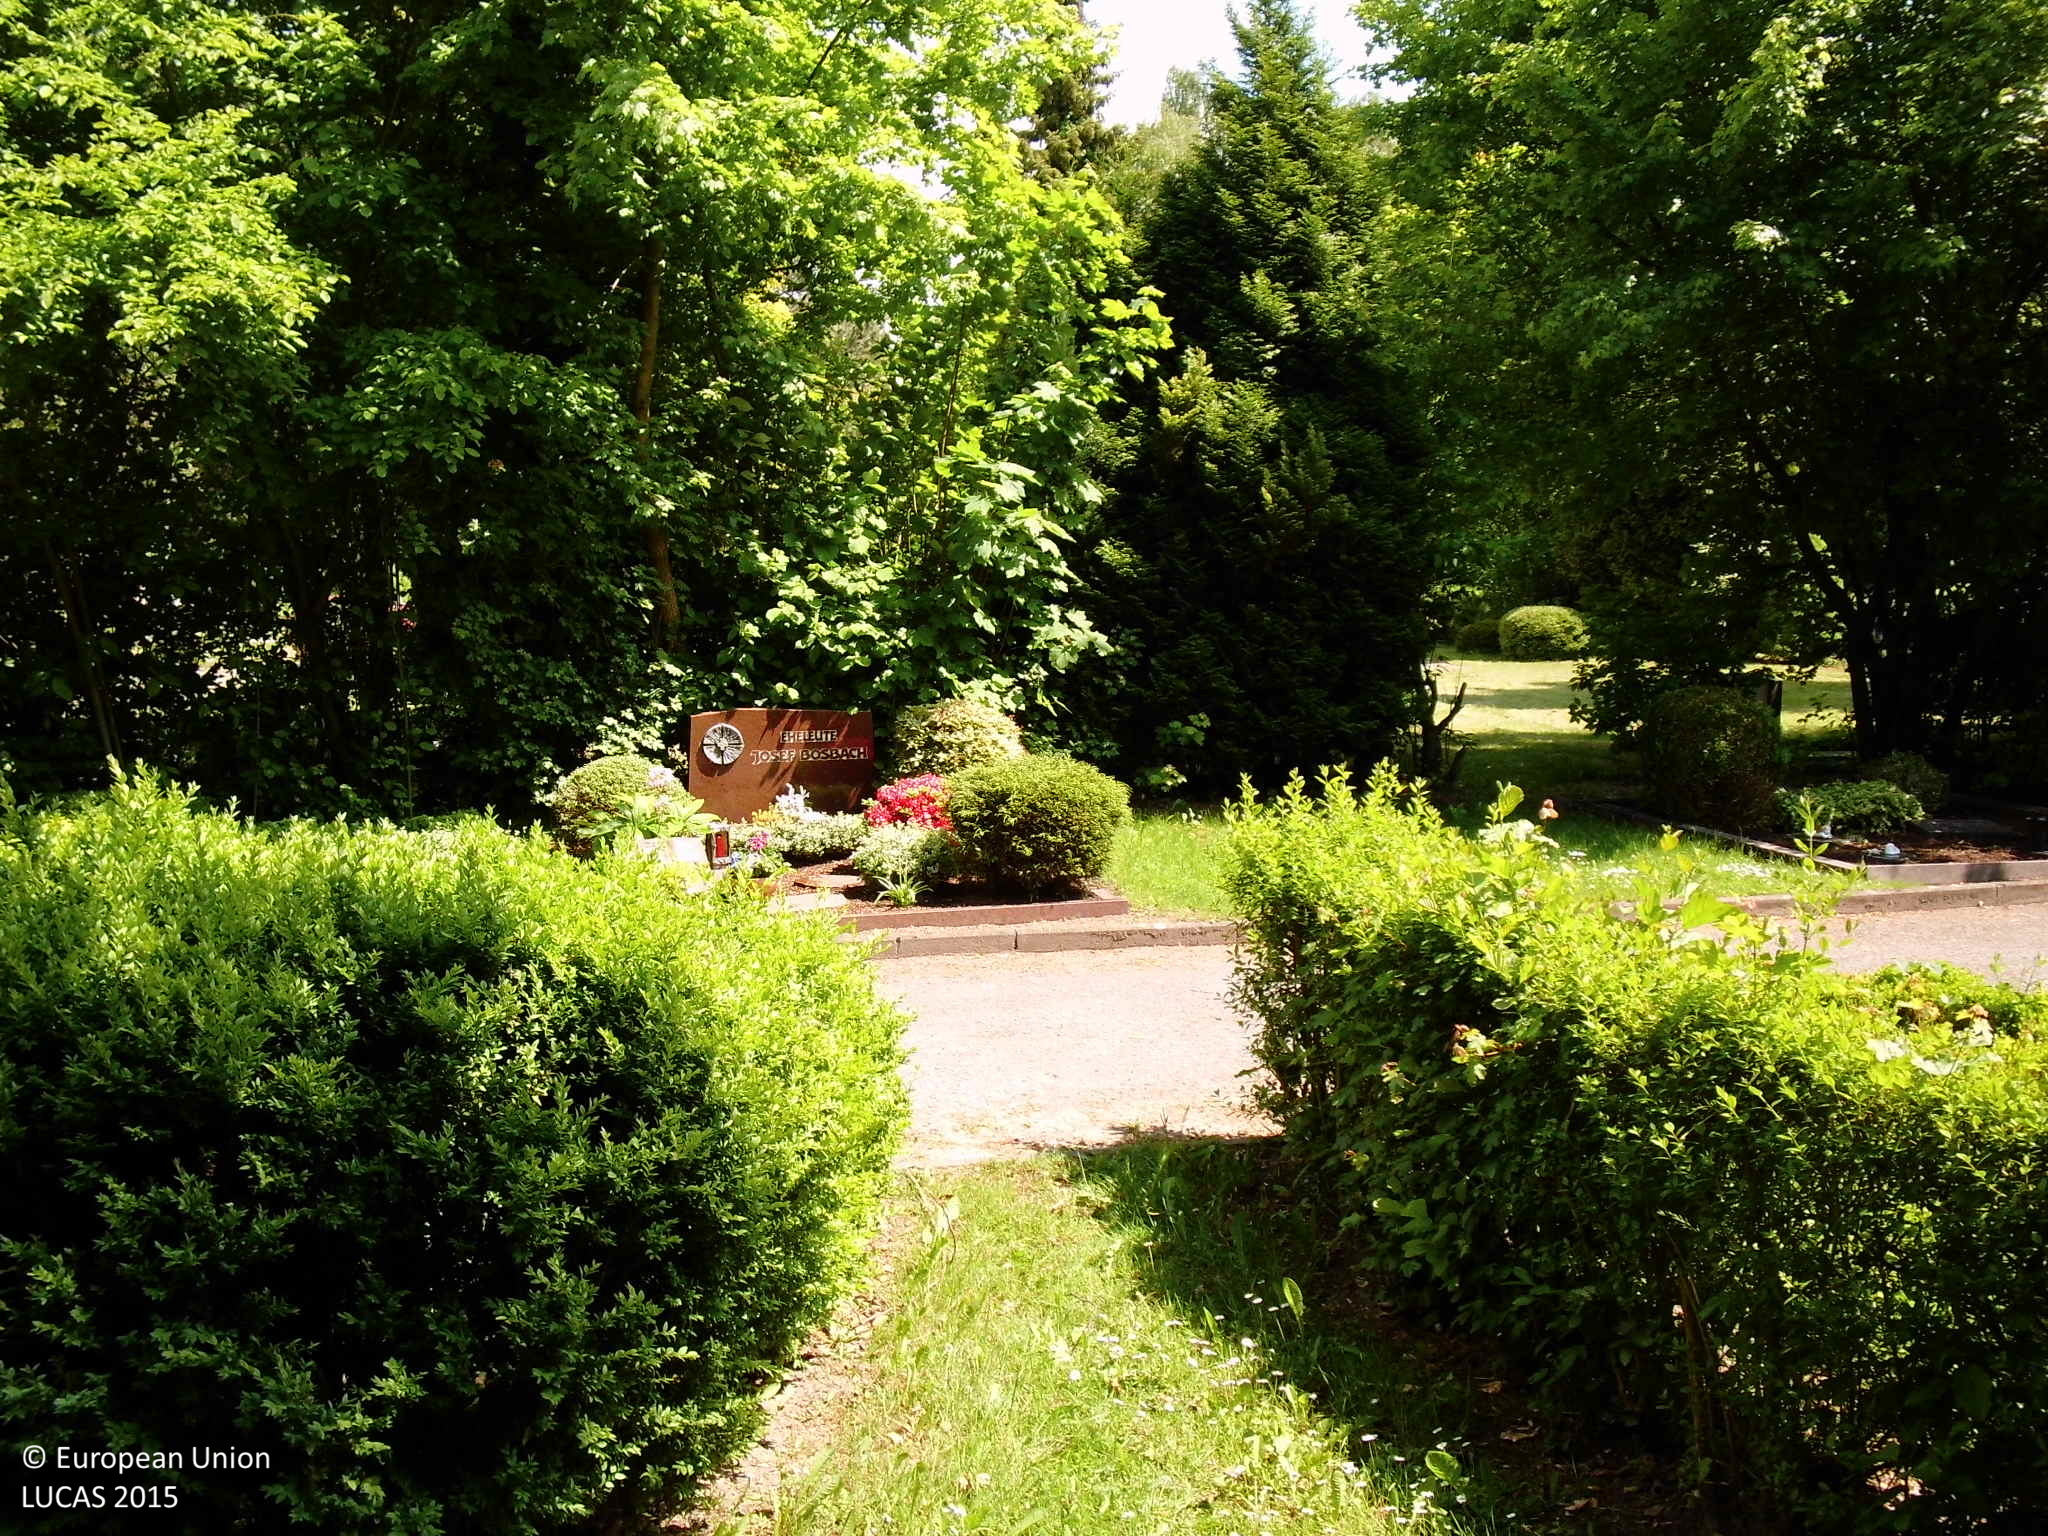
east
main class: Woodland
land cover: Broadleaved woodland
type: beech forest
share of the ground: 25 - 50 %
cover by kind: broadleaved forest trees 40 %, herbaceous plants 30 %, shrubs 20 %, consolidated bare surface 5 %, unconsolidated bare surface 5 %
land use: Community services
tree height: > 5 m
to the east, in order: Broadleaved woodland; Artificial constructions in urban areas
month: May
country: DE
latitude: 51.6293
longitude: 7.3854
